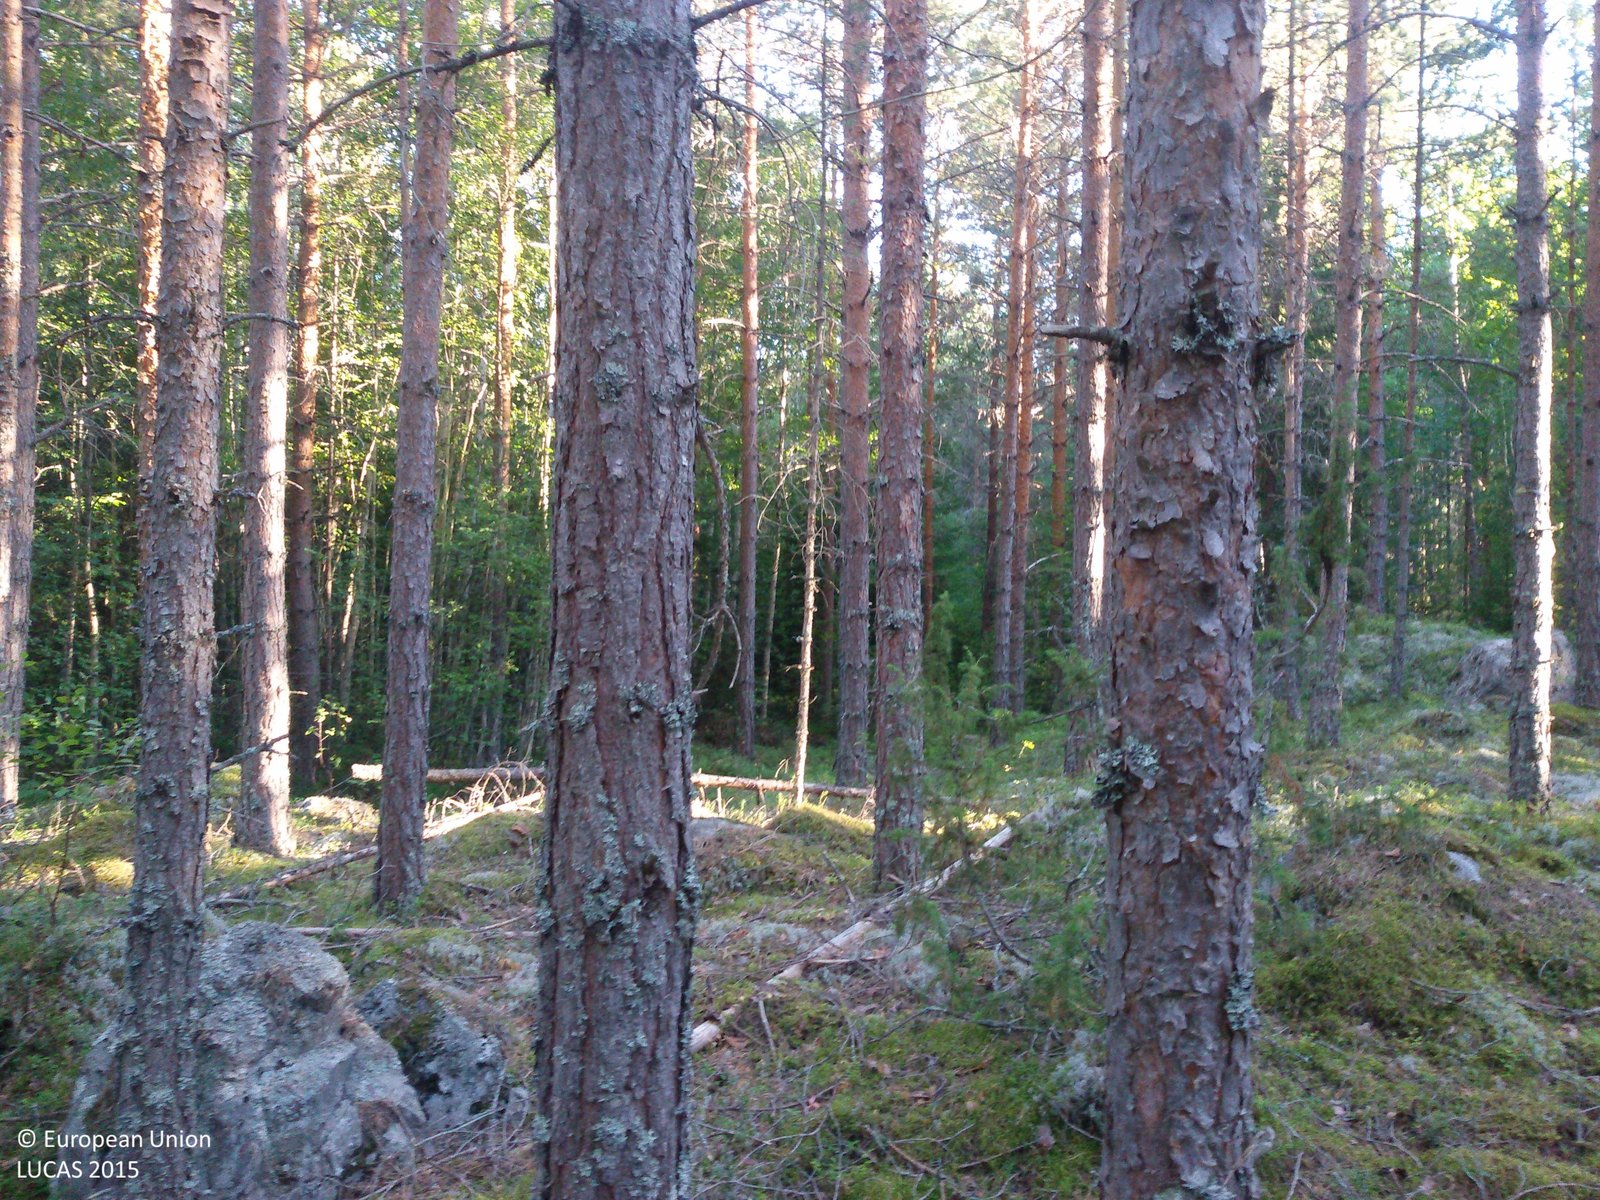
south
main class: Woodland
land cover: Pine dominated coniferous woodland
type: boreal forest
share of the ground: > 75 %
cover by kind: coniferous forest trees 80 %, lichens and mosses 15 %, shrubs 5 %
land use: Forestry
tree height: > 5 m
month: August
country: SE
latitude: 60.6893
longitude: 15.9020
